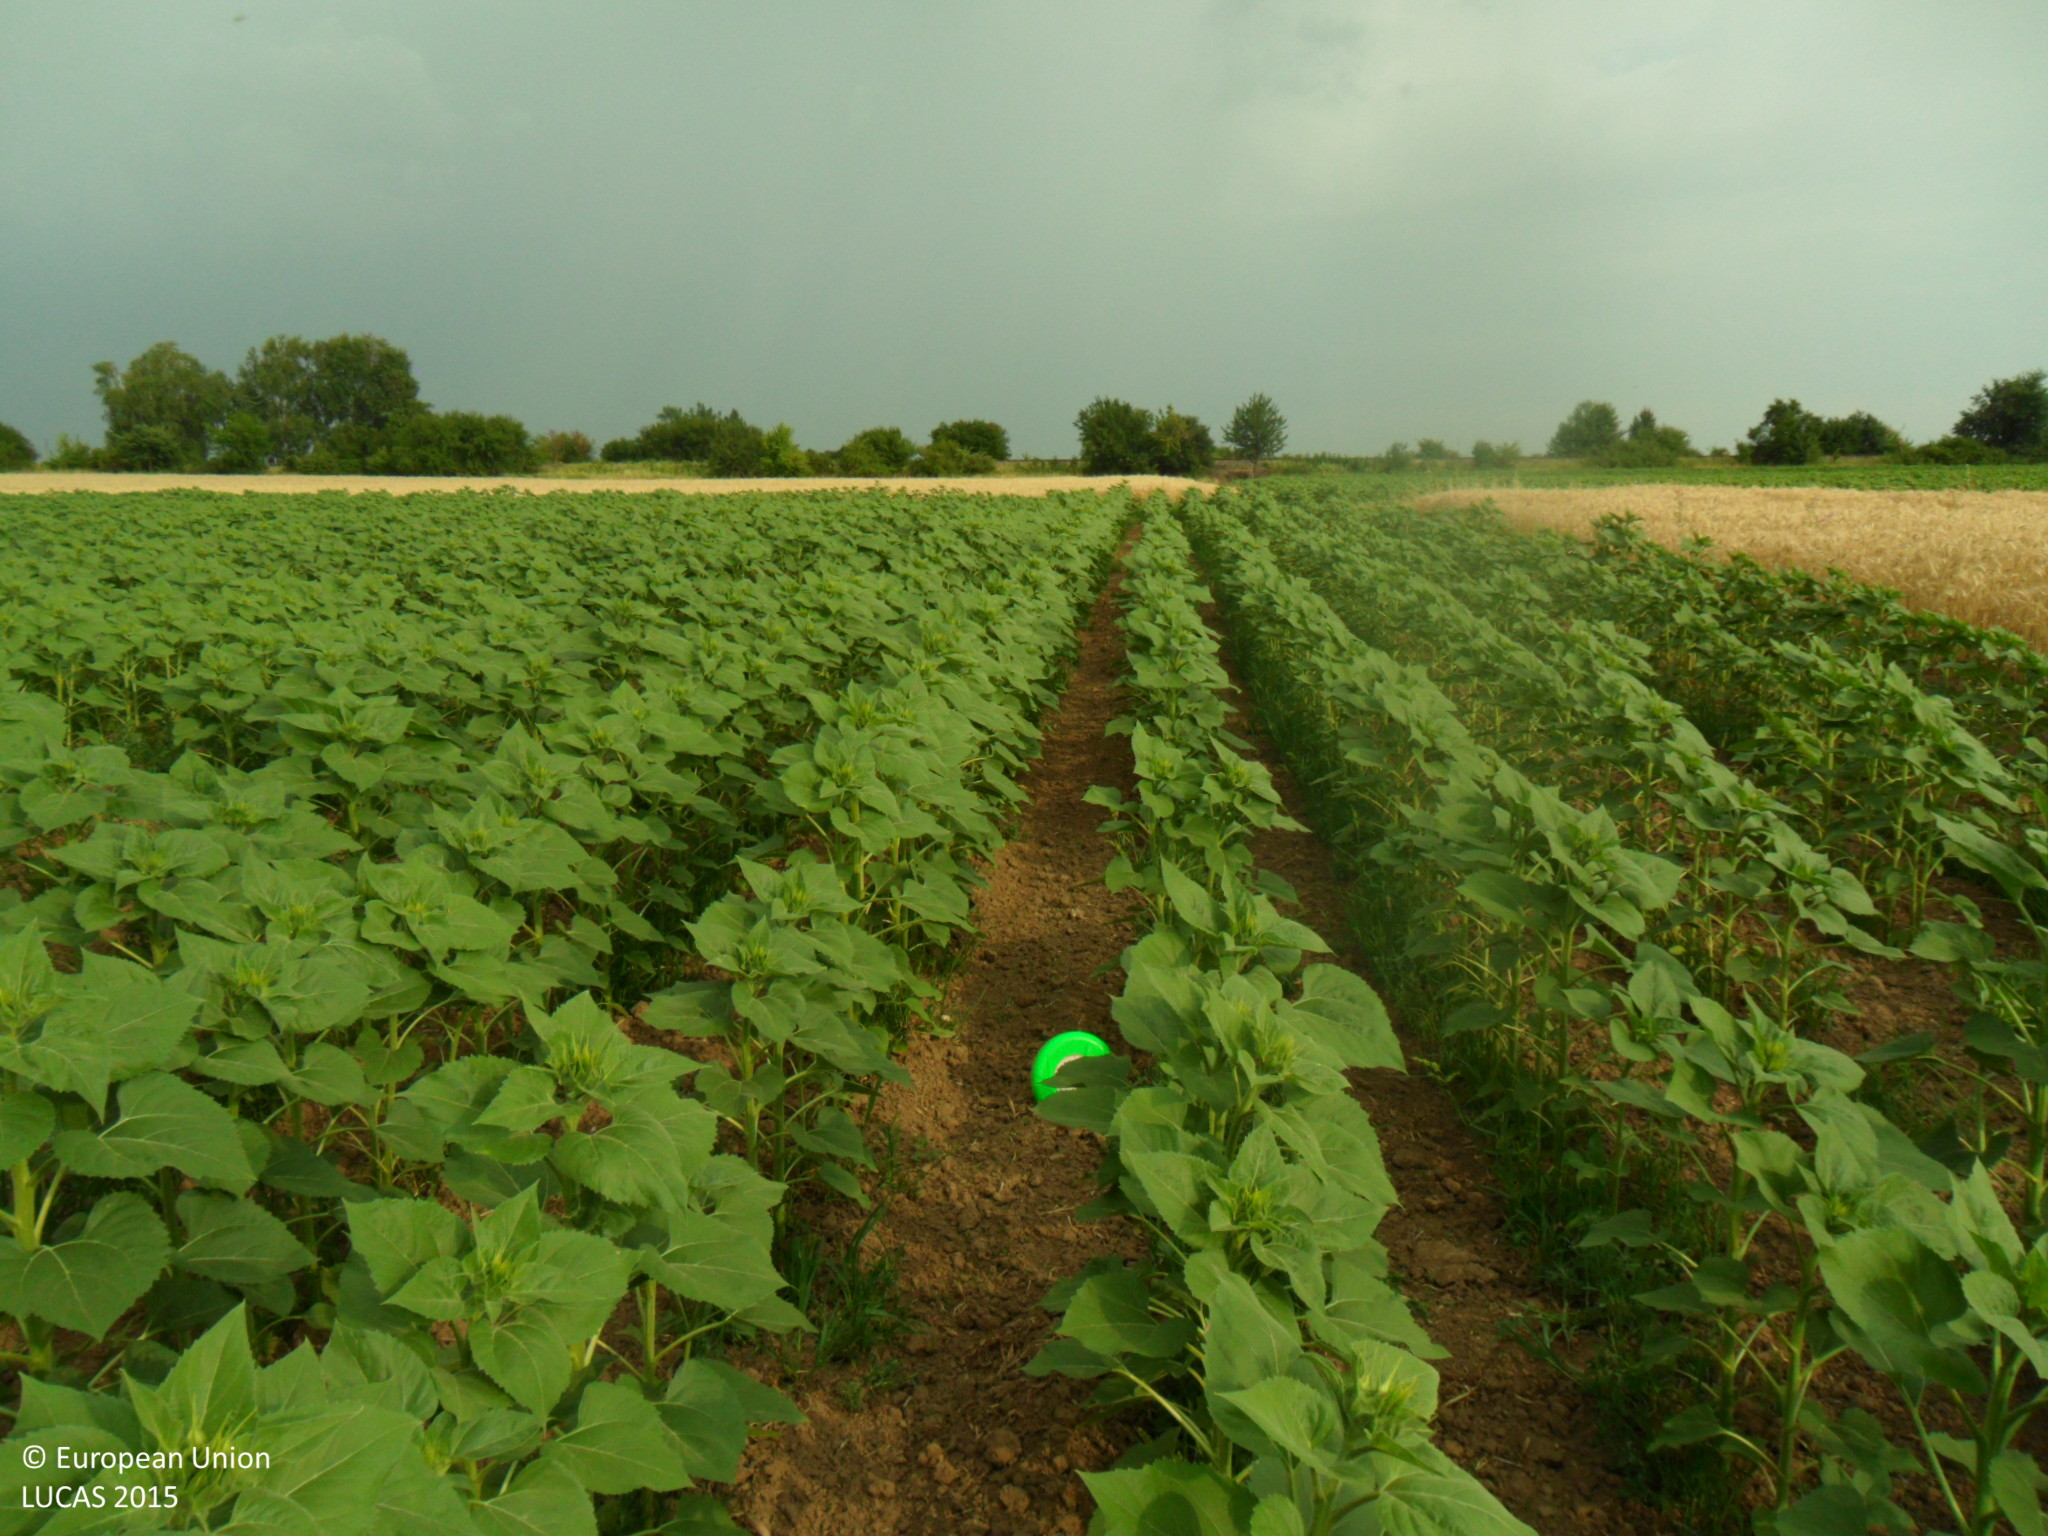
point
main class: Cropland
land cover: Sunflower
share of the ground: > 75 %
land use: Agriculture (excluding fallow land and kitchen gardens)
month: July
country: BG
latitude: 43.5730
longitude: 26.8174
